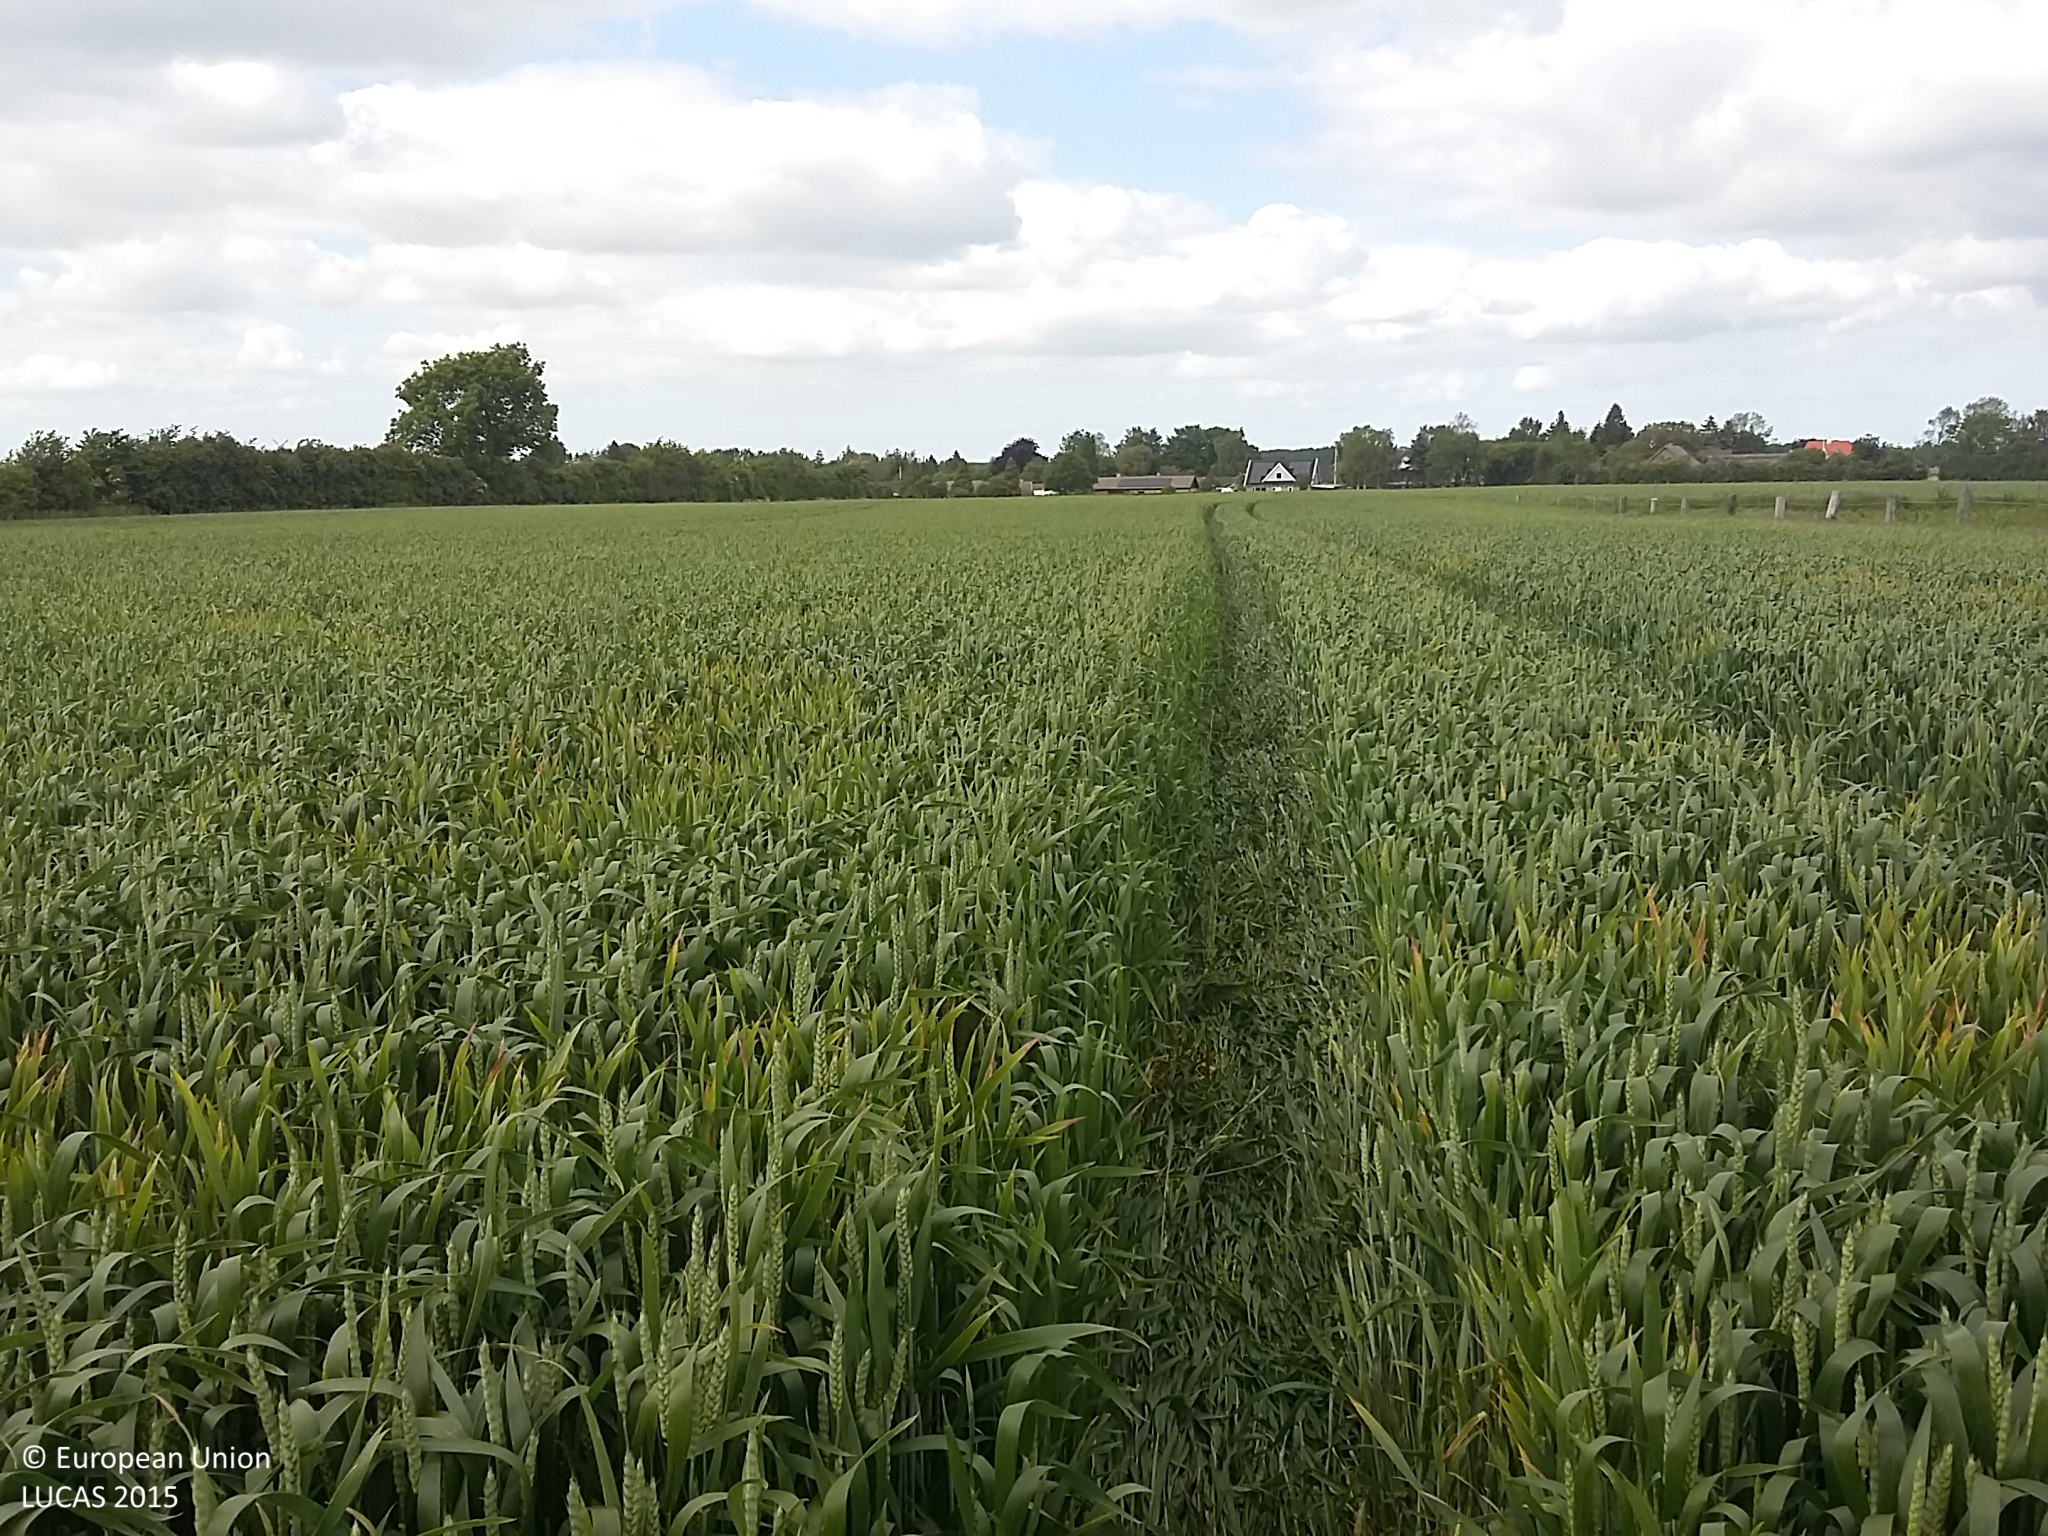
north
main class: Cropland
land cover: Common wheat
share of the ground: > 75 %
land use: Agriculture (excluding fallow land and kitchen gardens)
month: June
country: DK
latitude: 55.2696
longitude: 10.6133
